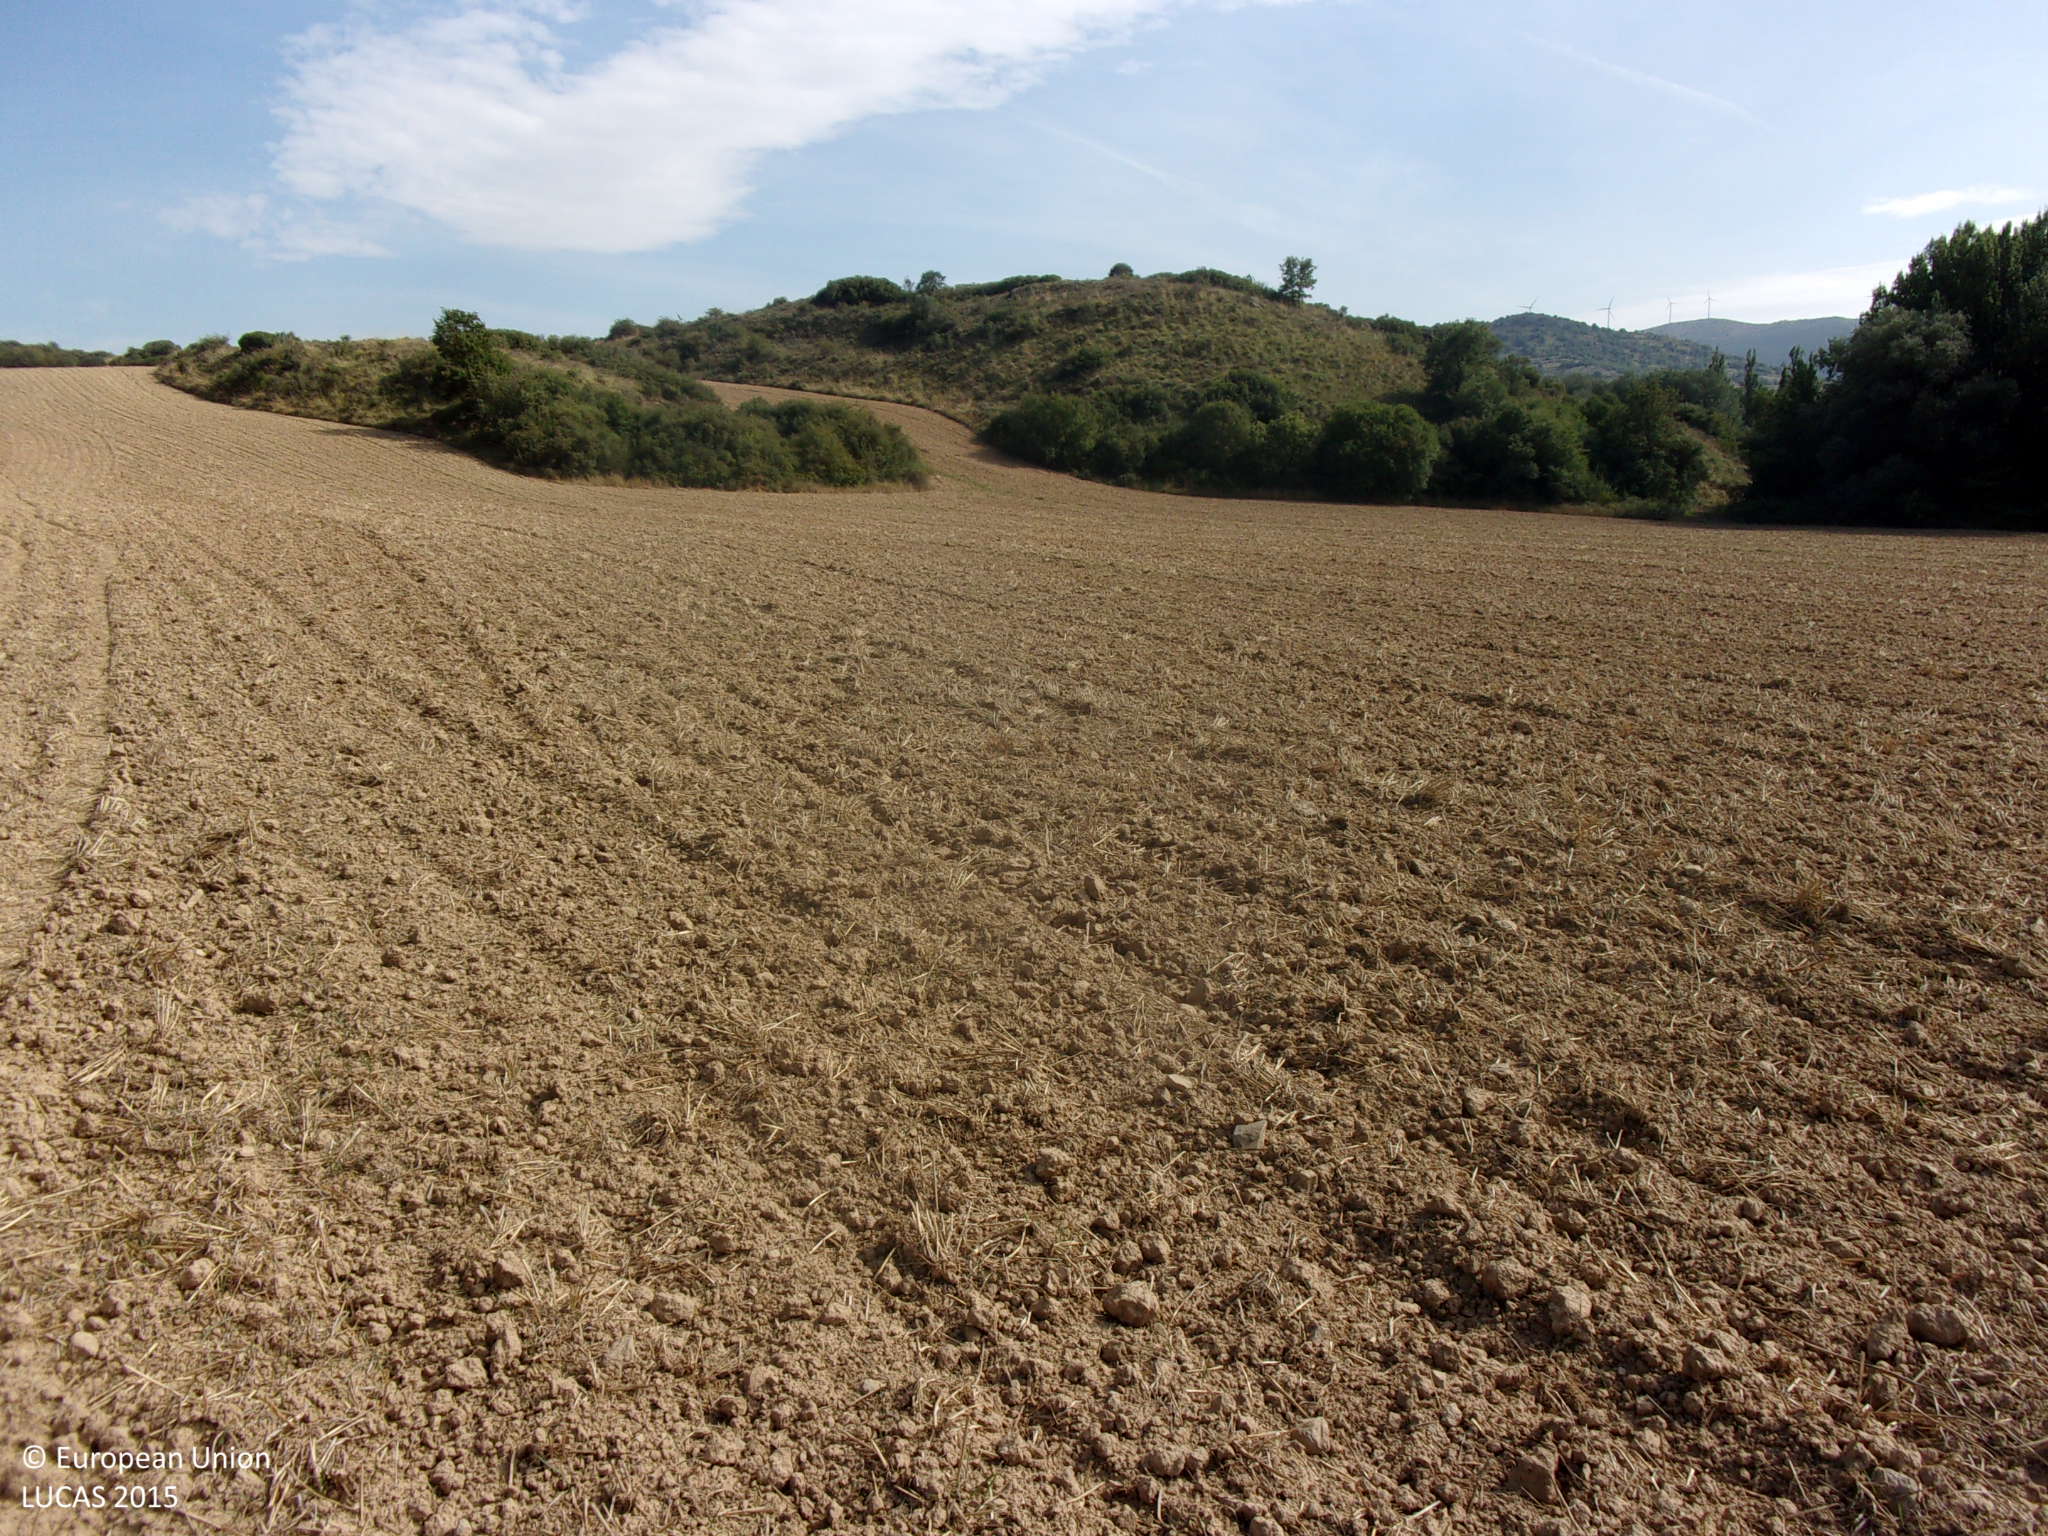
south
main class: Cropland
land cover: Common wheat
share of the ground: < 10 %
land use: Agriculture (excluding fallow land and kitchen gardens)
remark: Harvested field
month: August
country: ES
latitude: 42.5205
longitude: -1.2189
